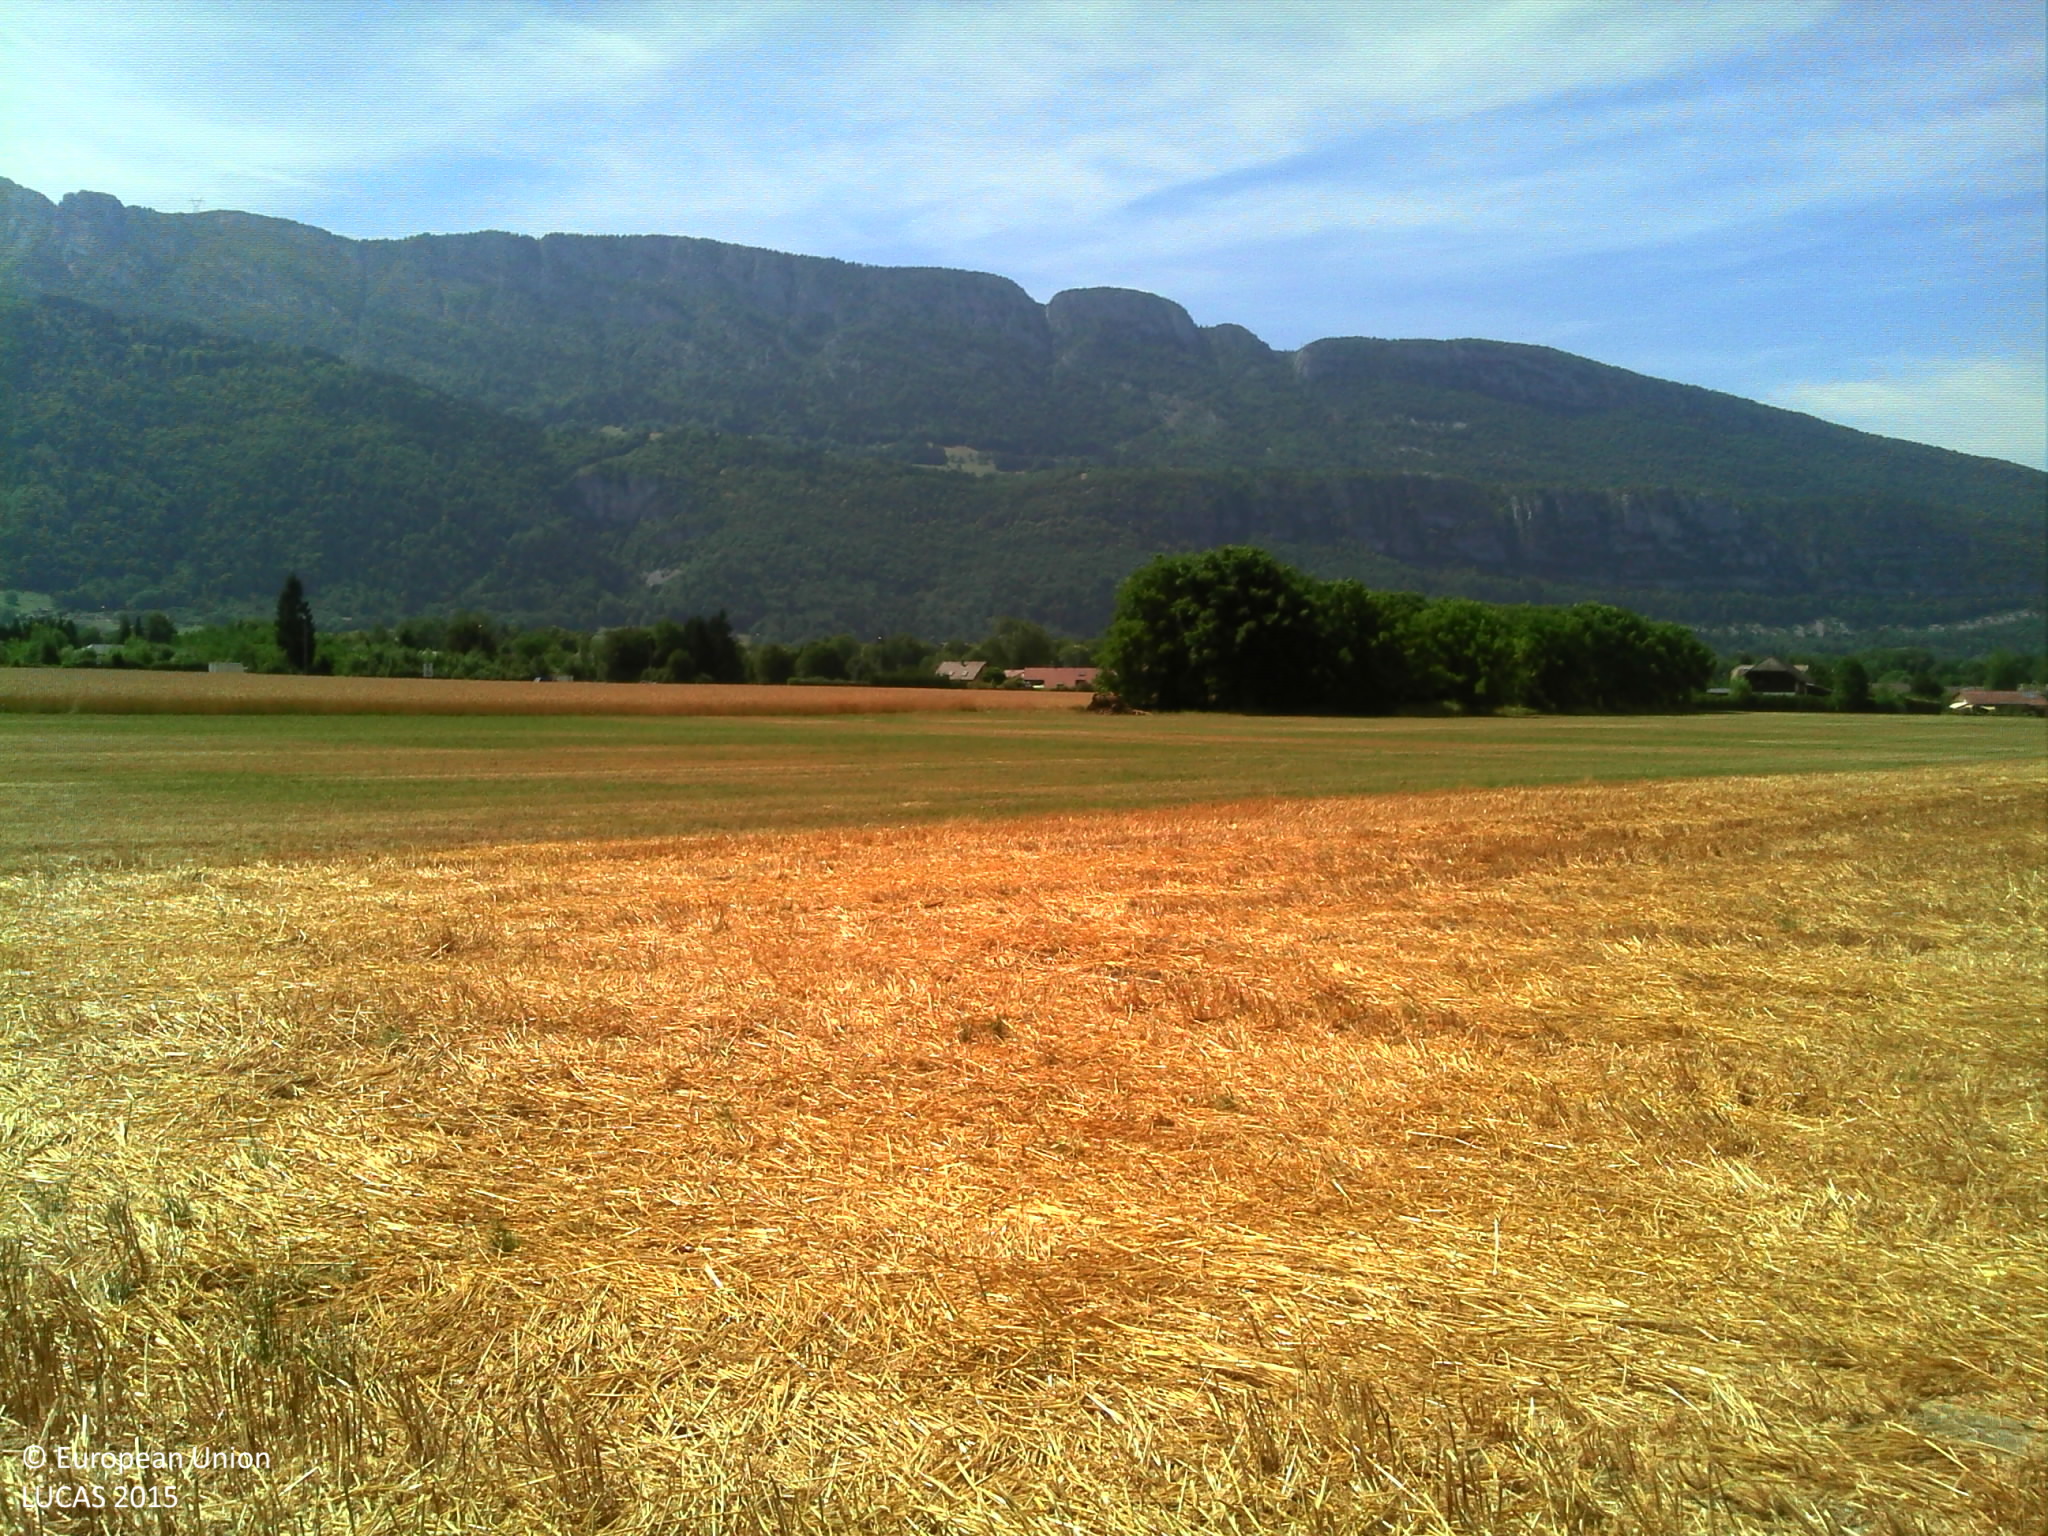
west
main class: Cropland
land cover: Rye
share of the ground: < 10 %
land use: Agriculture (excluding fallow land and kitchen gardens)
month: July
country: FR
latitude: 45.7801
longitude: 6.2357
